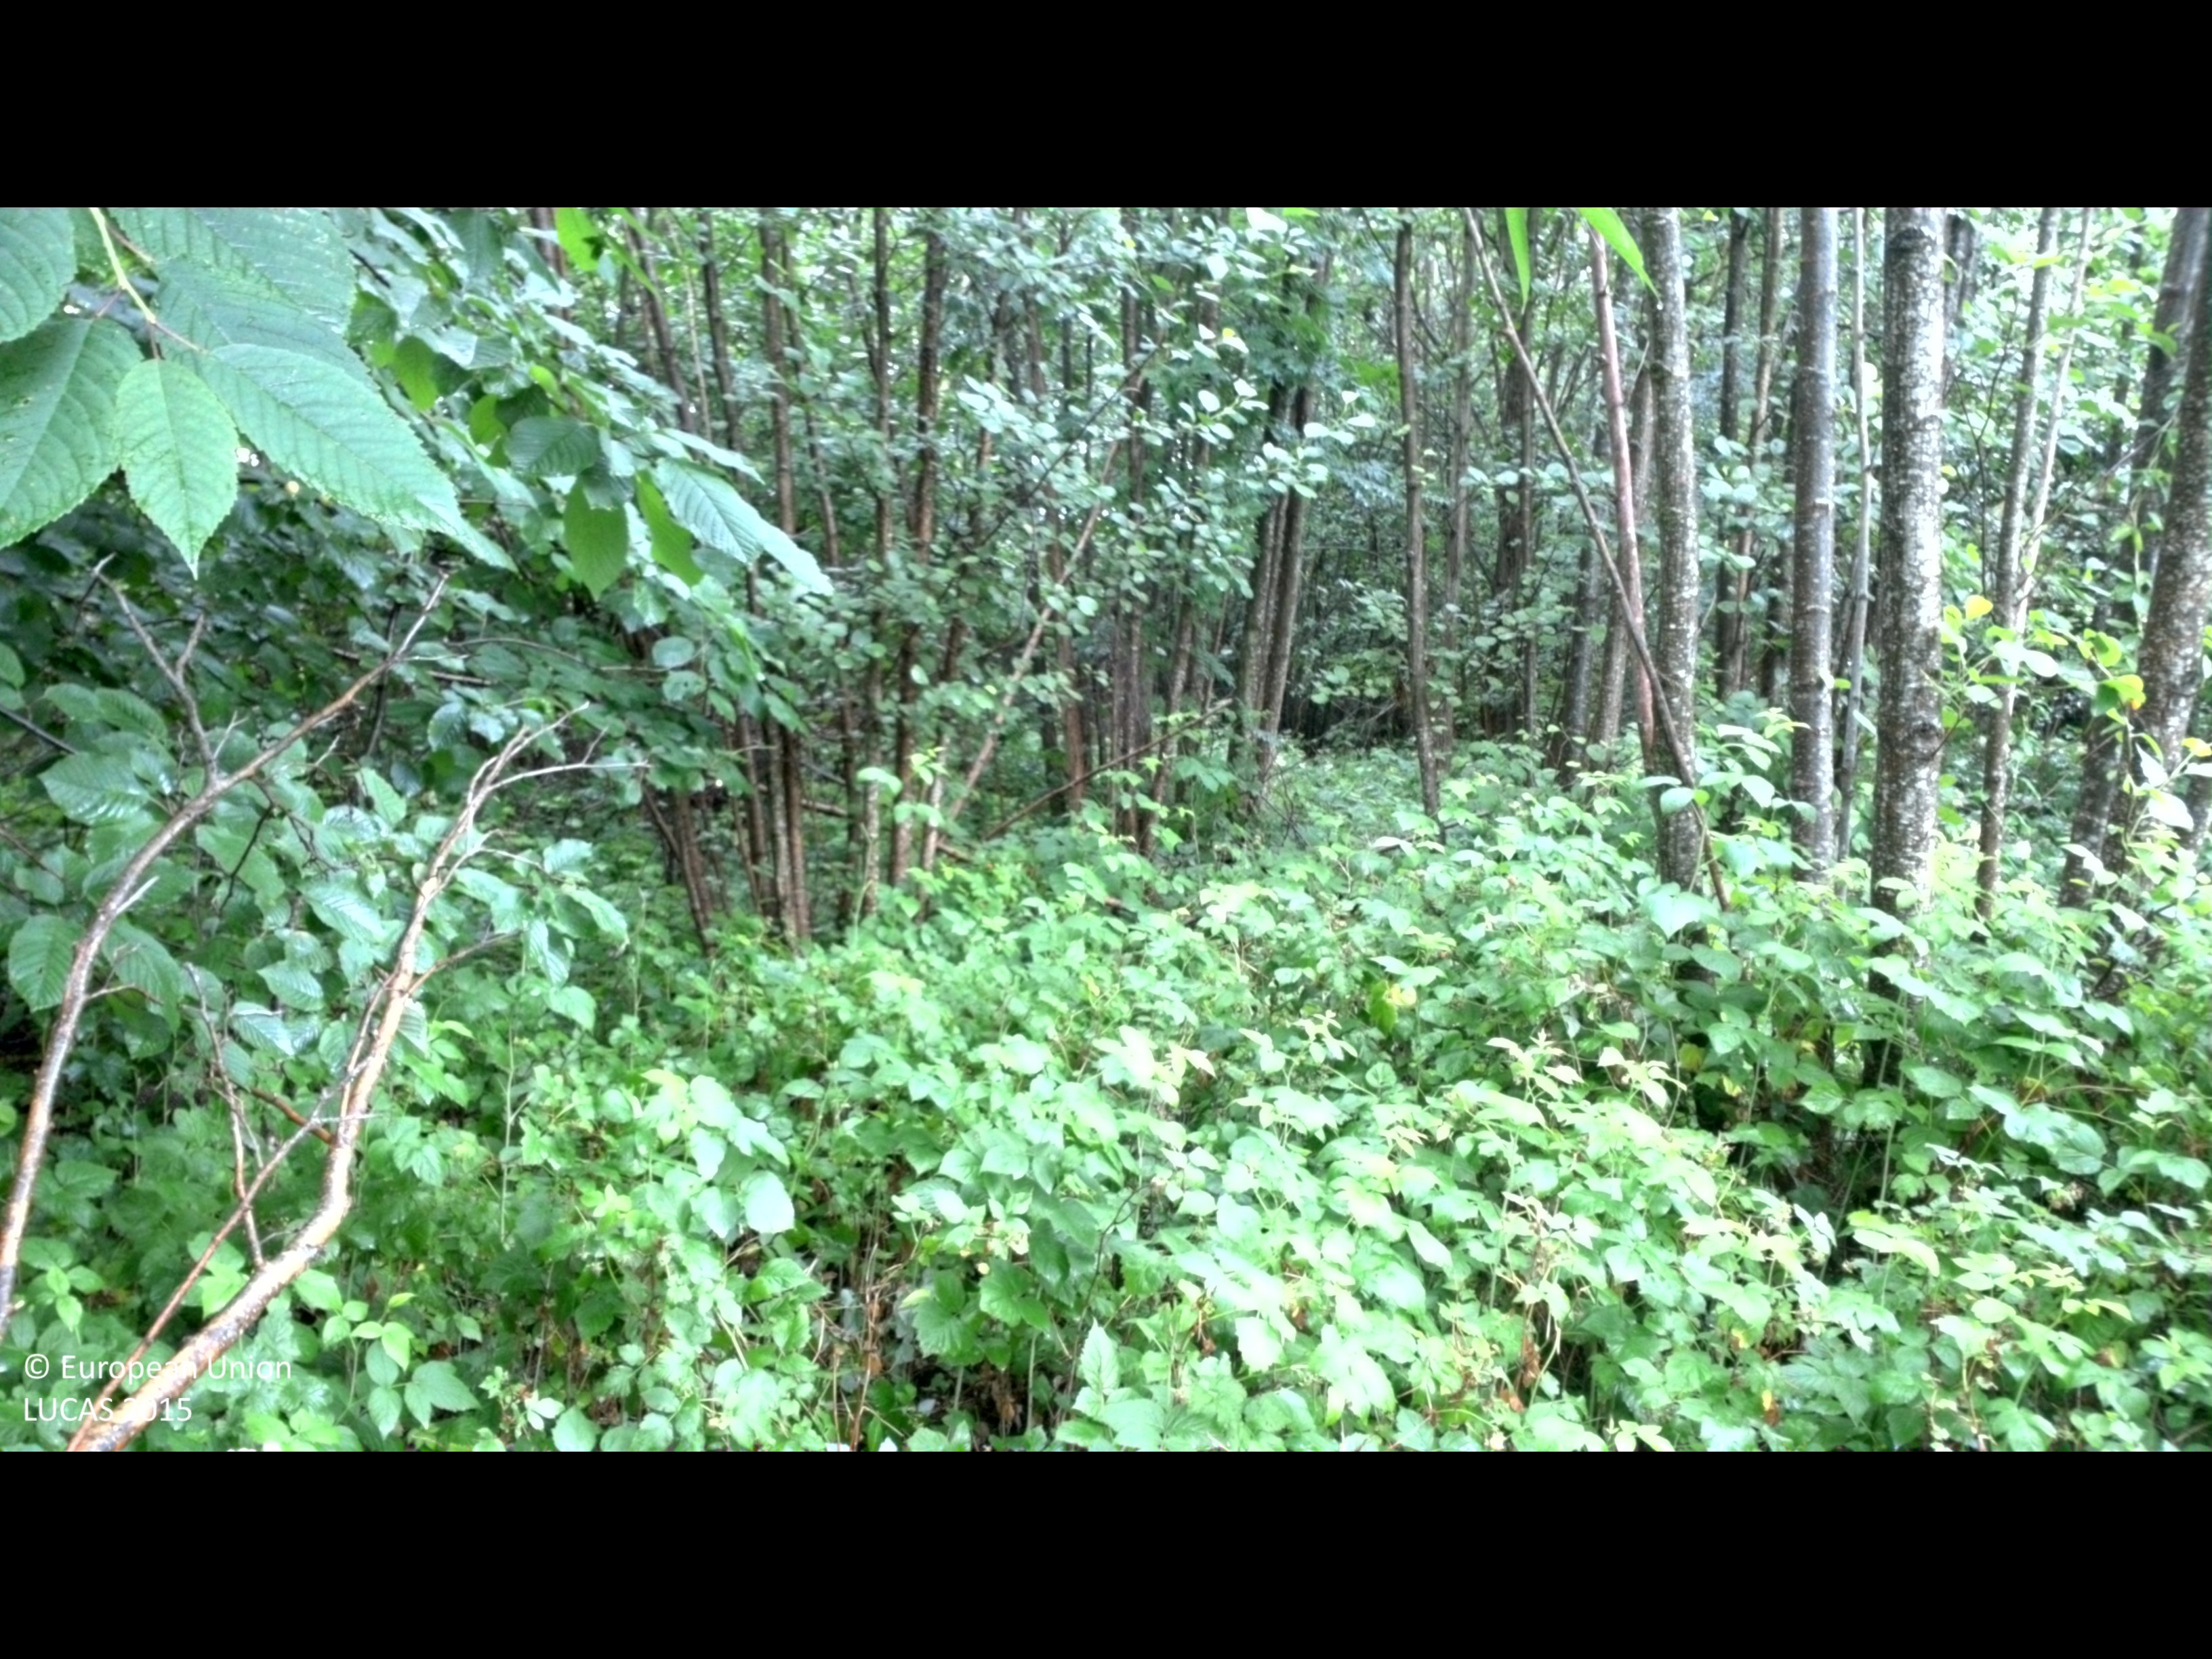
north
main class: Woodland
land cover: Broadleaved woodland
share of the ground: > 75 %
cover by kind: broadleaved forest trees 80 %, shrubs 20 %
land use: Amenities, museums, leisure
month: July
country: SE
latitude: 56.6378
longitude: 16.4743
